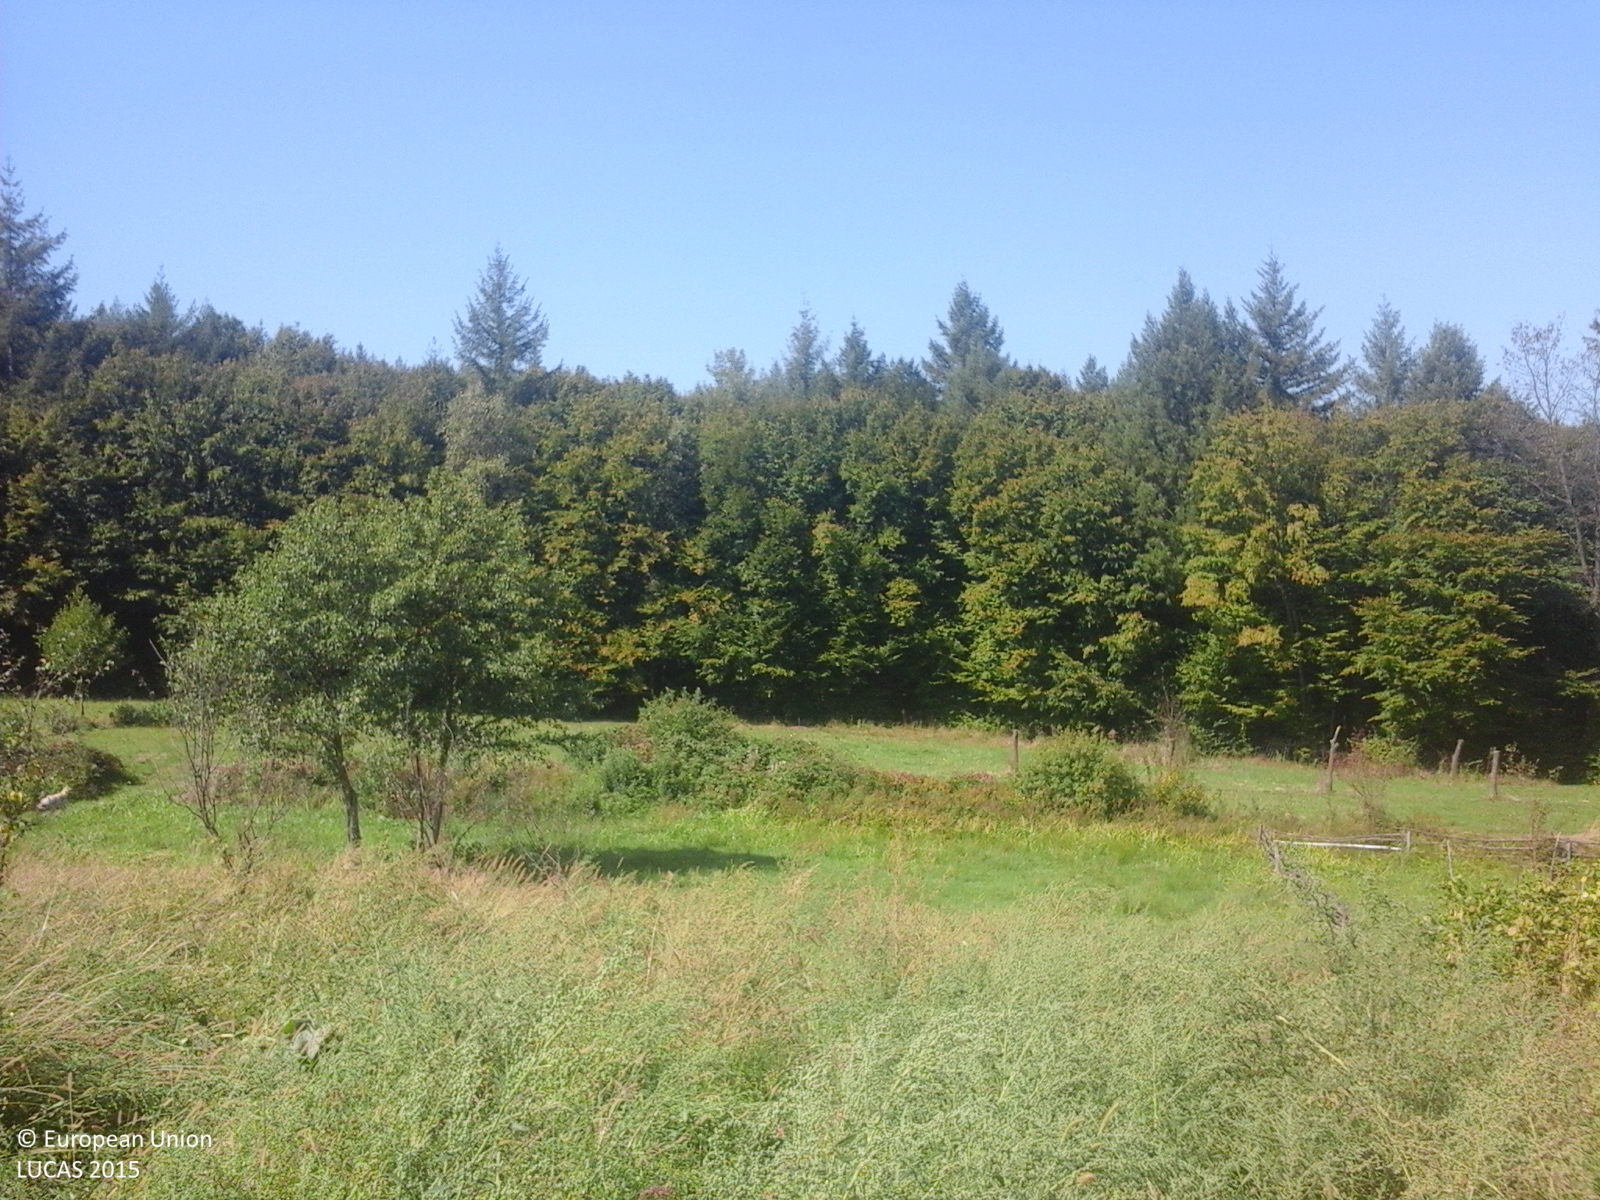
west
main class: Grassland
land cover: Grassland without tree/shrub cover
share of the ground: > 75 %
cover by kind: herbaceous plants 100 %
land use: Agriculture (excluding fallow land and kitchen gardens)
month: September
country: RO
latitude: 47.0829
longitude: 22.7159
